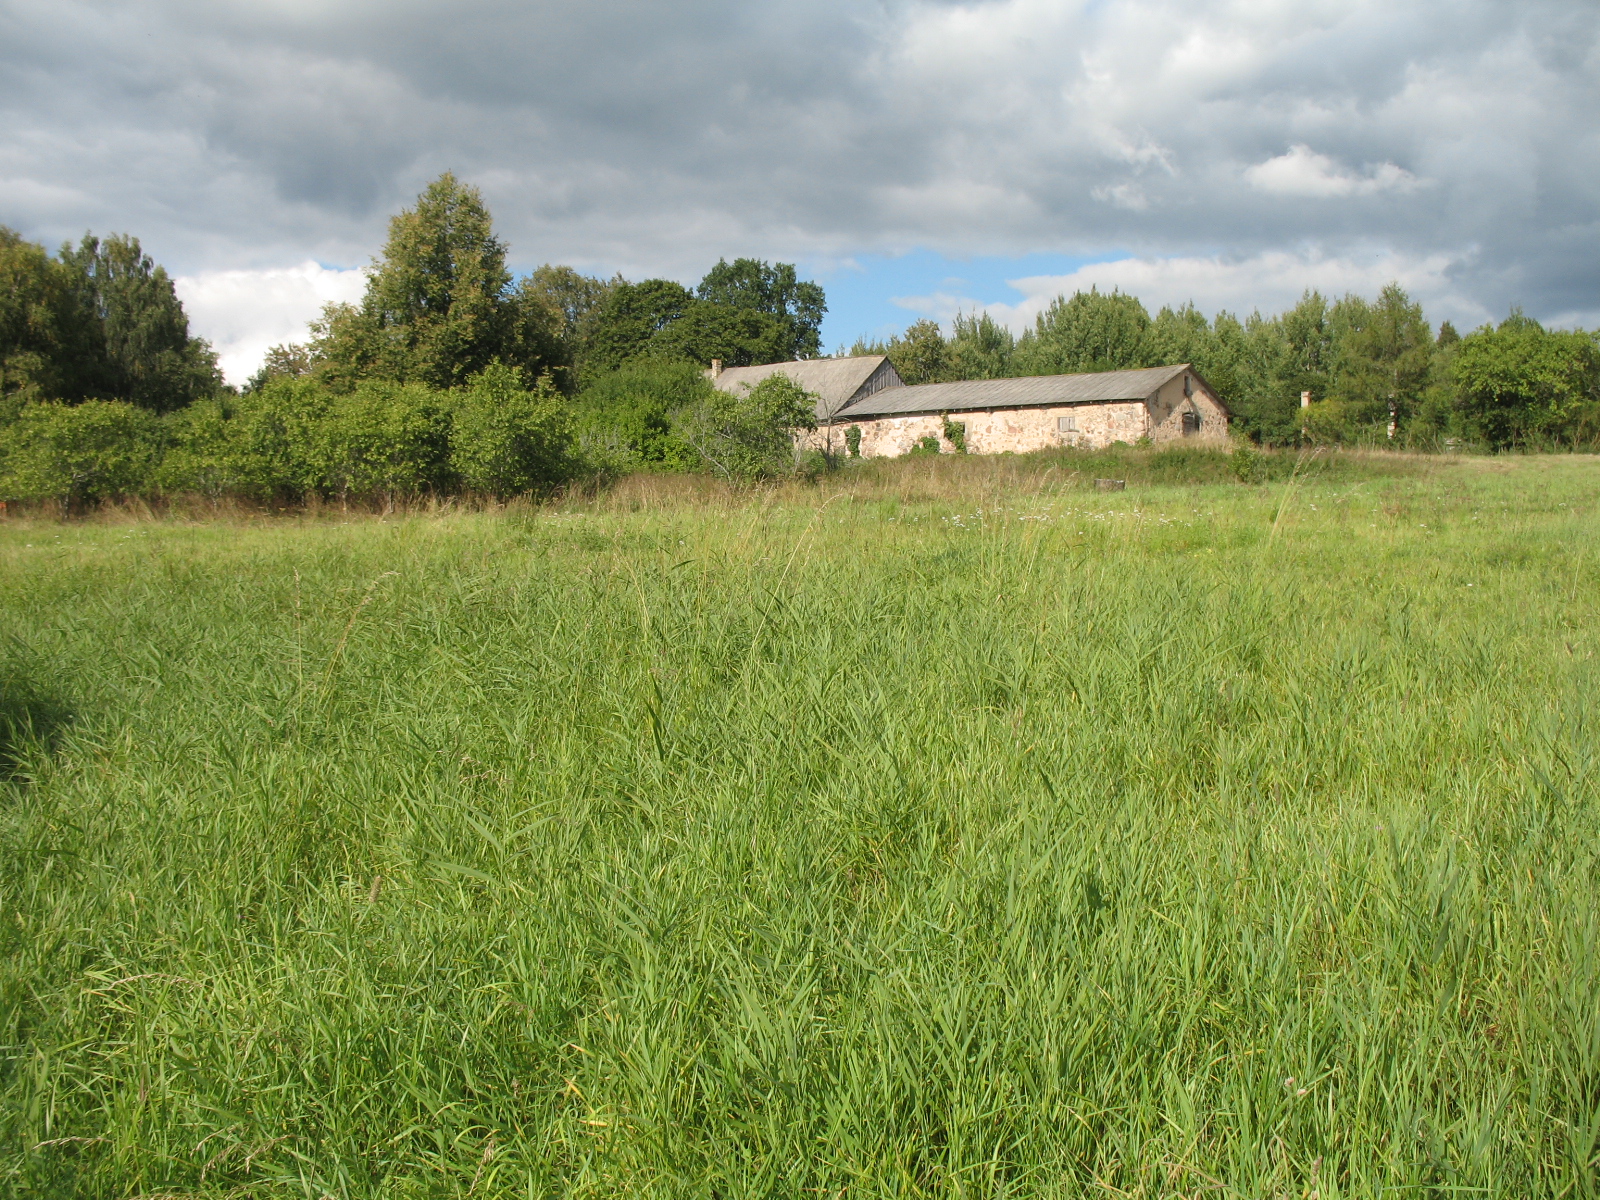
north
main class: Grassland
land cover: Grassland without tree/shrub cover
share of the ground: > 75 %
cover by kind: herbaceous plants 100 %
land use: Agriculture (excluding fallow land and kitchen gardens)
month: September
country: LV
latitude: 56.1554
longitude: 25.4966
